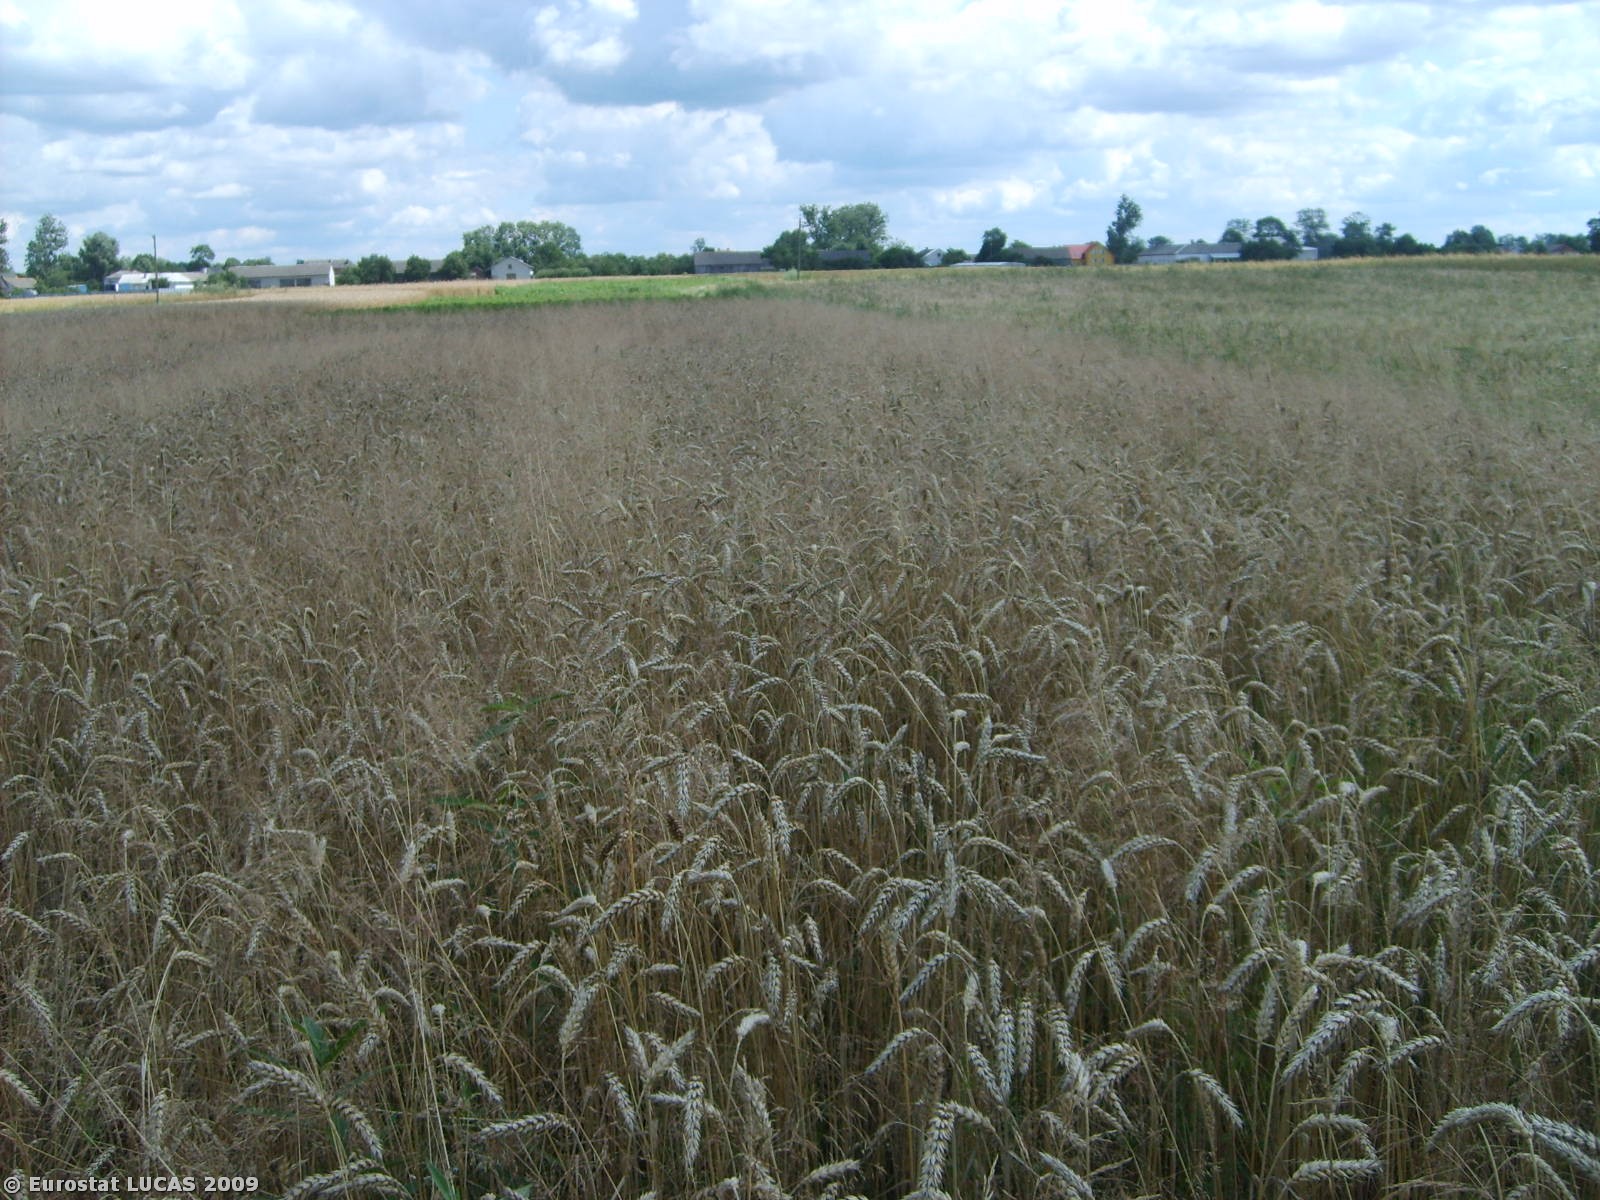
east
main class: Cropland
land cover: Common wheat
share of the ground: > 75 %
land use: Agriculture (excluding fallow land and kitchen gardens)
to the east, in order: Common wheat; Potatoes; Grass margins; Potatoes; Common wheat
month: July
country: PL
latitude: 51.6105
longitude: 21.5612
